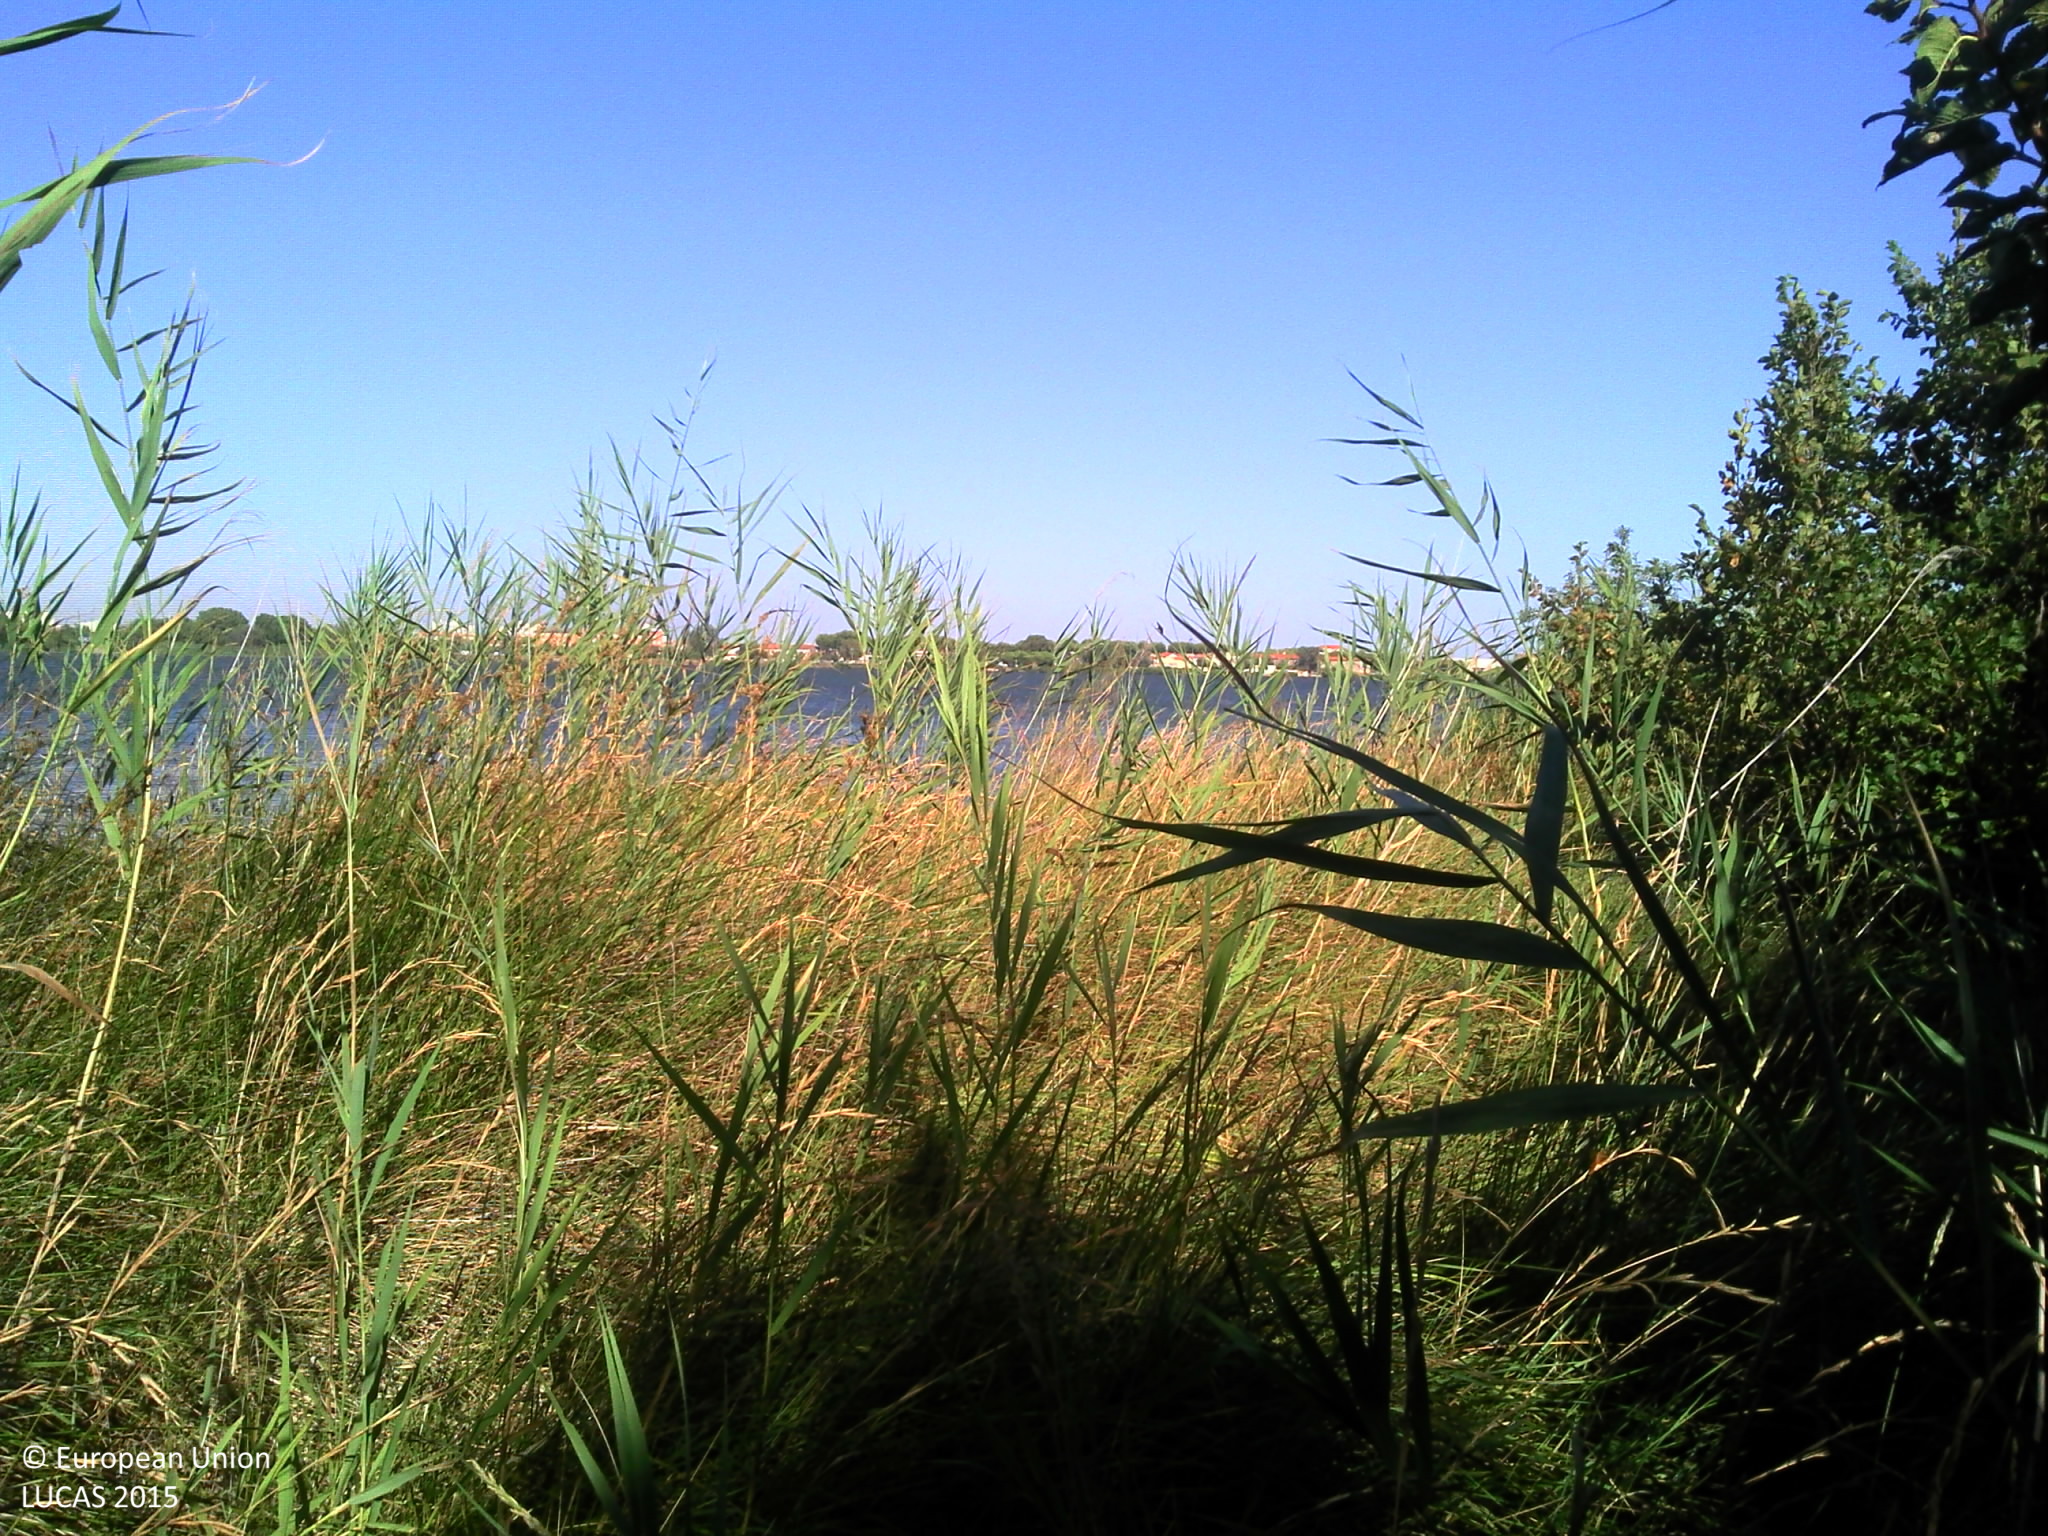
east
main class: Grassland
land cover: Spontaneously vegetated surfaces
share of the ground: 50 - 75 %
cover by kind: herbaceous plants 50 %, shrubs 5 %
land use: Semi-natural and natural areas not in use
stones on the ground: < 10 %
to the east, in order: Spontaneously vegetated surfaces; Inland fresh running water
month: July
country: FR
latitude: 43.3881
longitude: 4.7886
